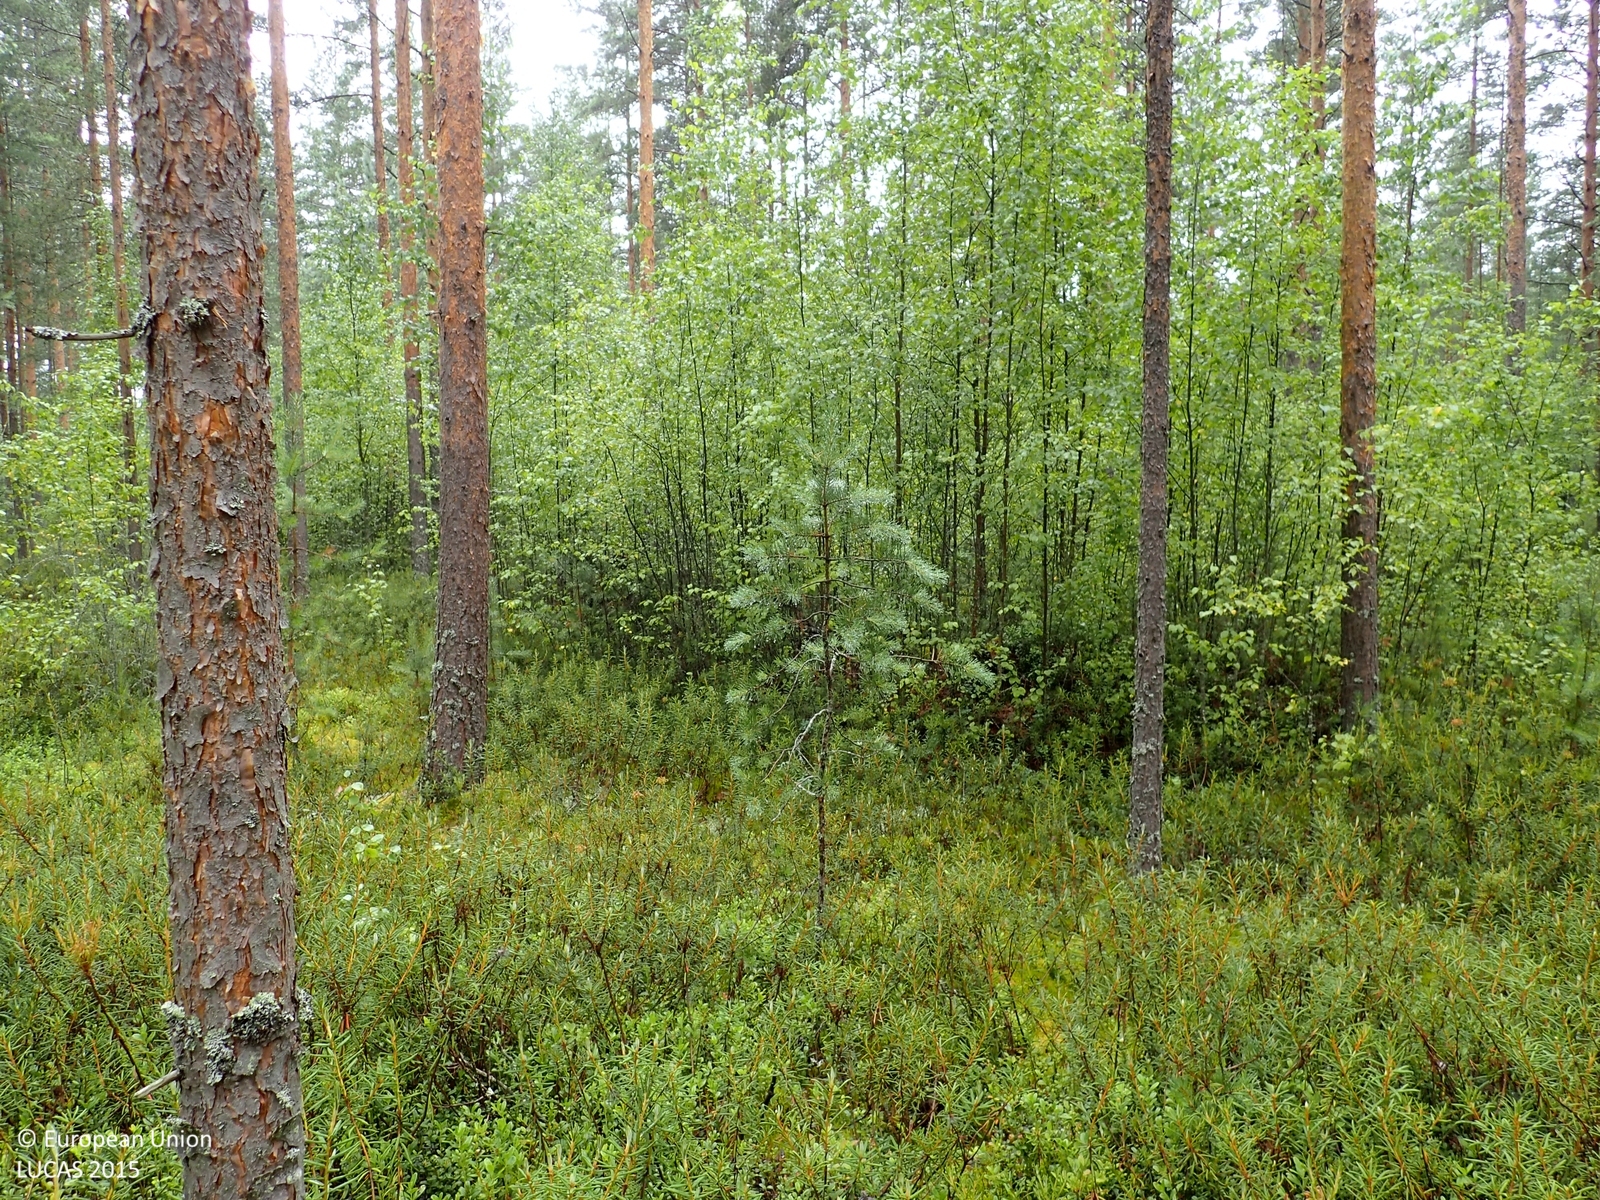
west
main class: Woodland
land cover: Pine dominated mixed woodland
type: boreal forest
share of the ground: 50 - 75 %
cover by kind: coniferous forest trees 45 %, shrubs 35 %, broadleaved forest trees 15 %, lichens and mosses 5 %
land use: Forestry
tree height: > 5 m
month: July
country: FI
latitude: 62.9852
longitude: 22.9441
